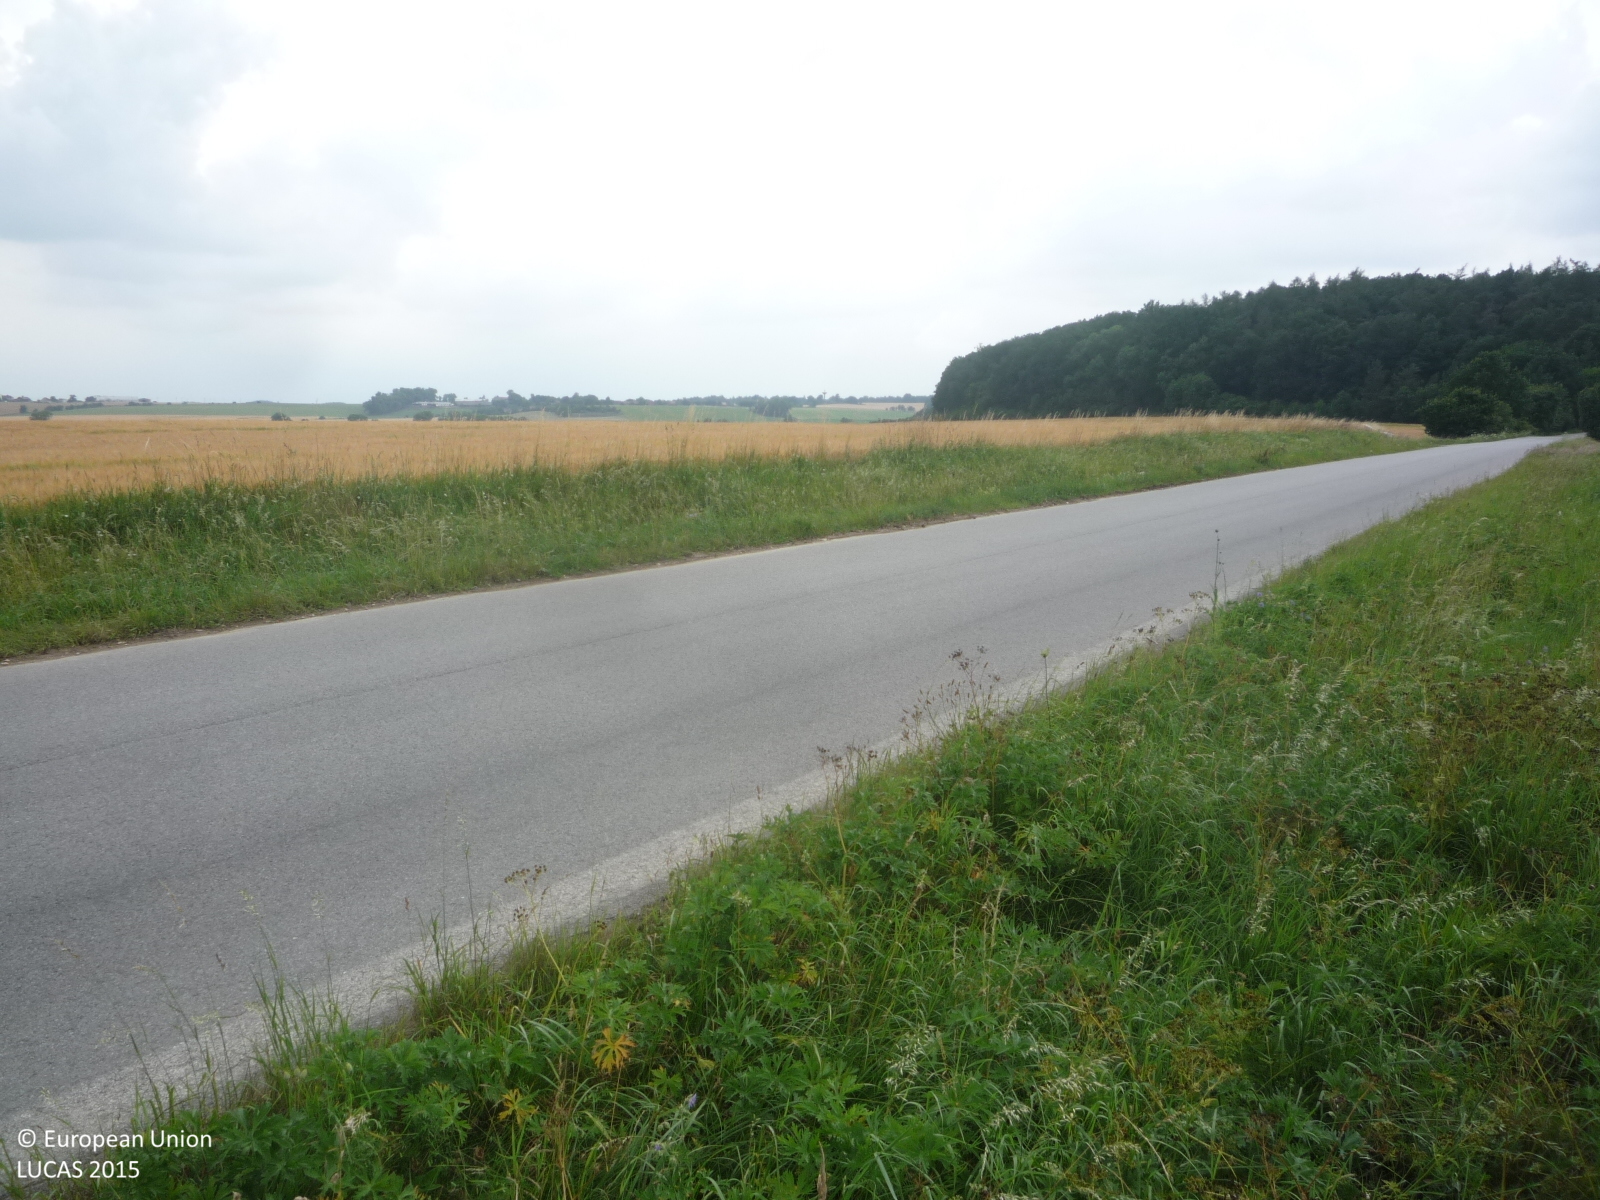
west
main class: Cropland
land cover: Rape and turnip rape
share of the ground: > 75 %
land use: Agriculture (excluding fallow land and kitchen gardens)
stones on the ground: < 10 %
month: July
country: CZ
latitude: 50.1168
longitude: 15.6405
